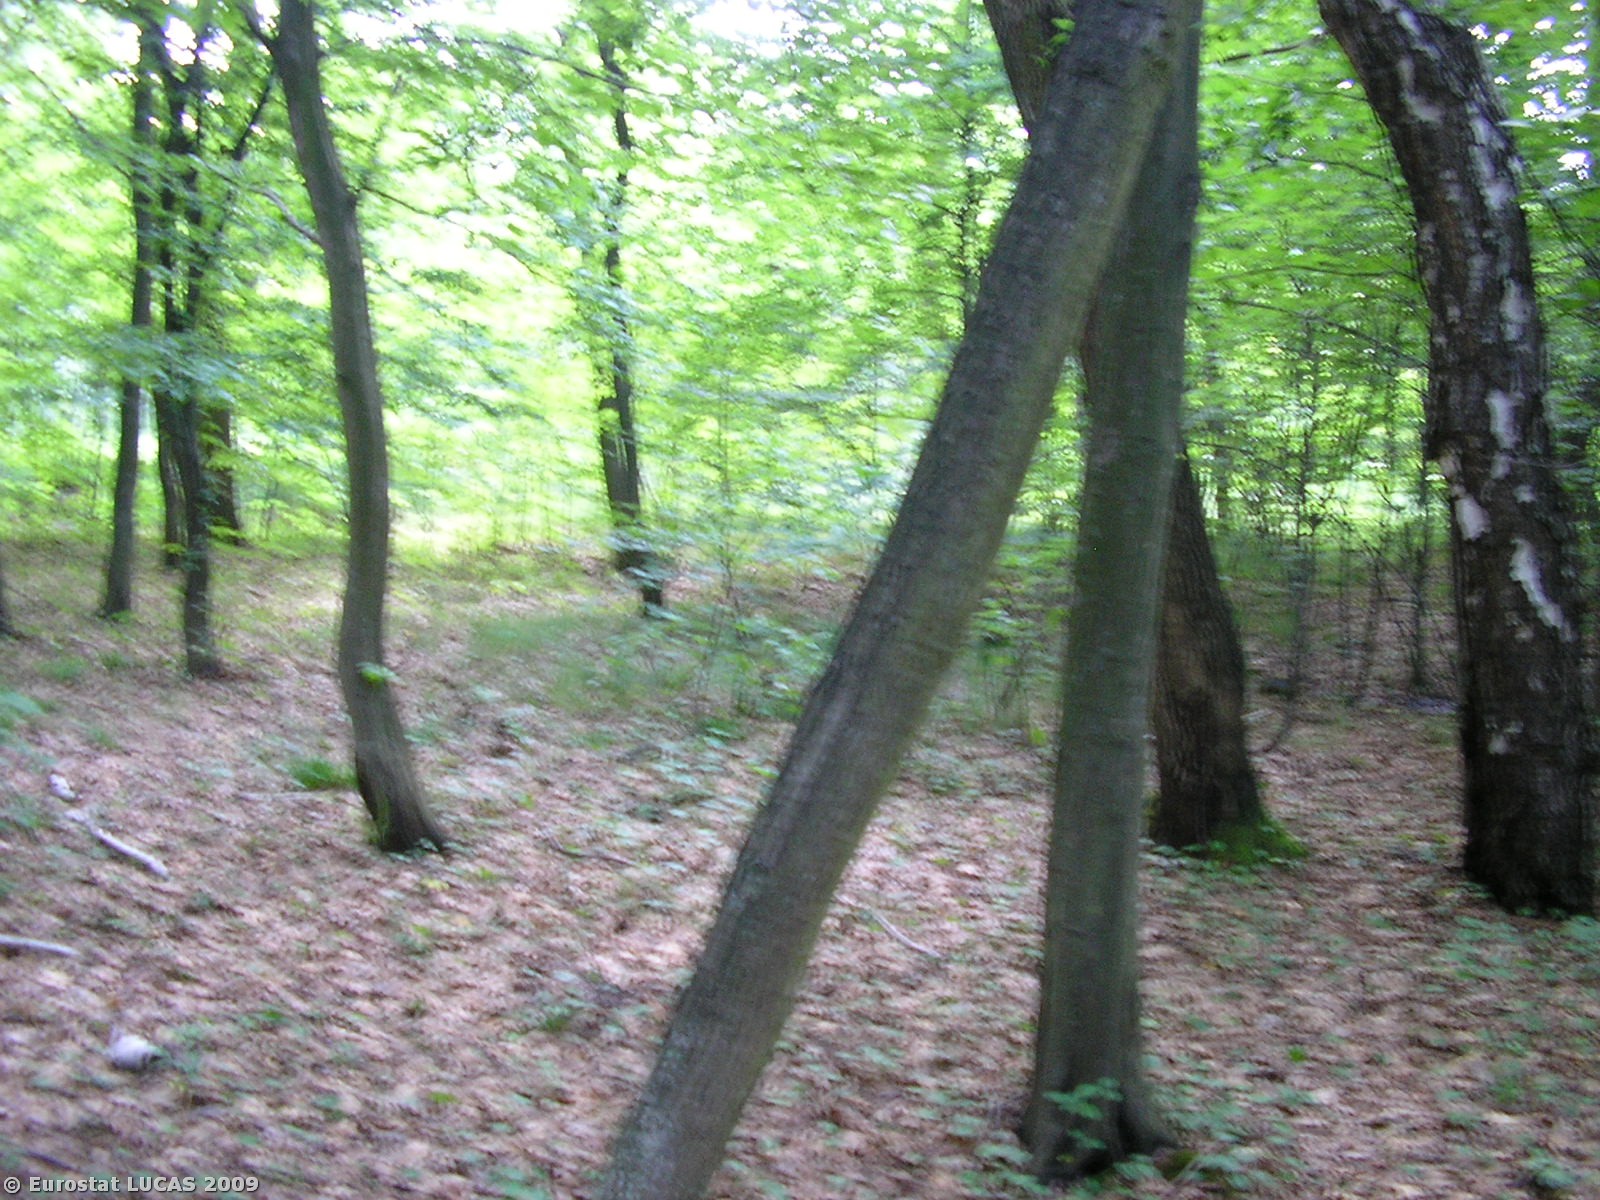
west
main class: Woodland
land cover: Broadleaved woodland
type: mesophytic deciduous forest
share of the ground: > 75 %
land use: Forestry
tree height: > 5 m
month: June
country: PL
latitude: 50.3879
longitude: 20.6873
